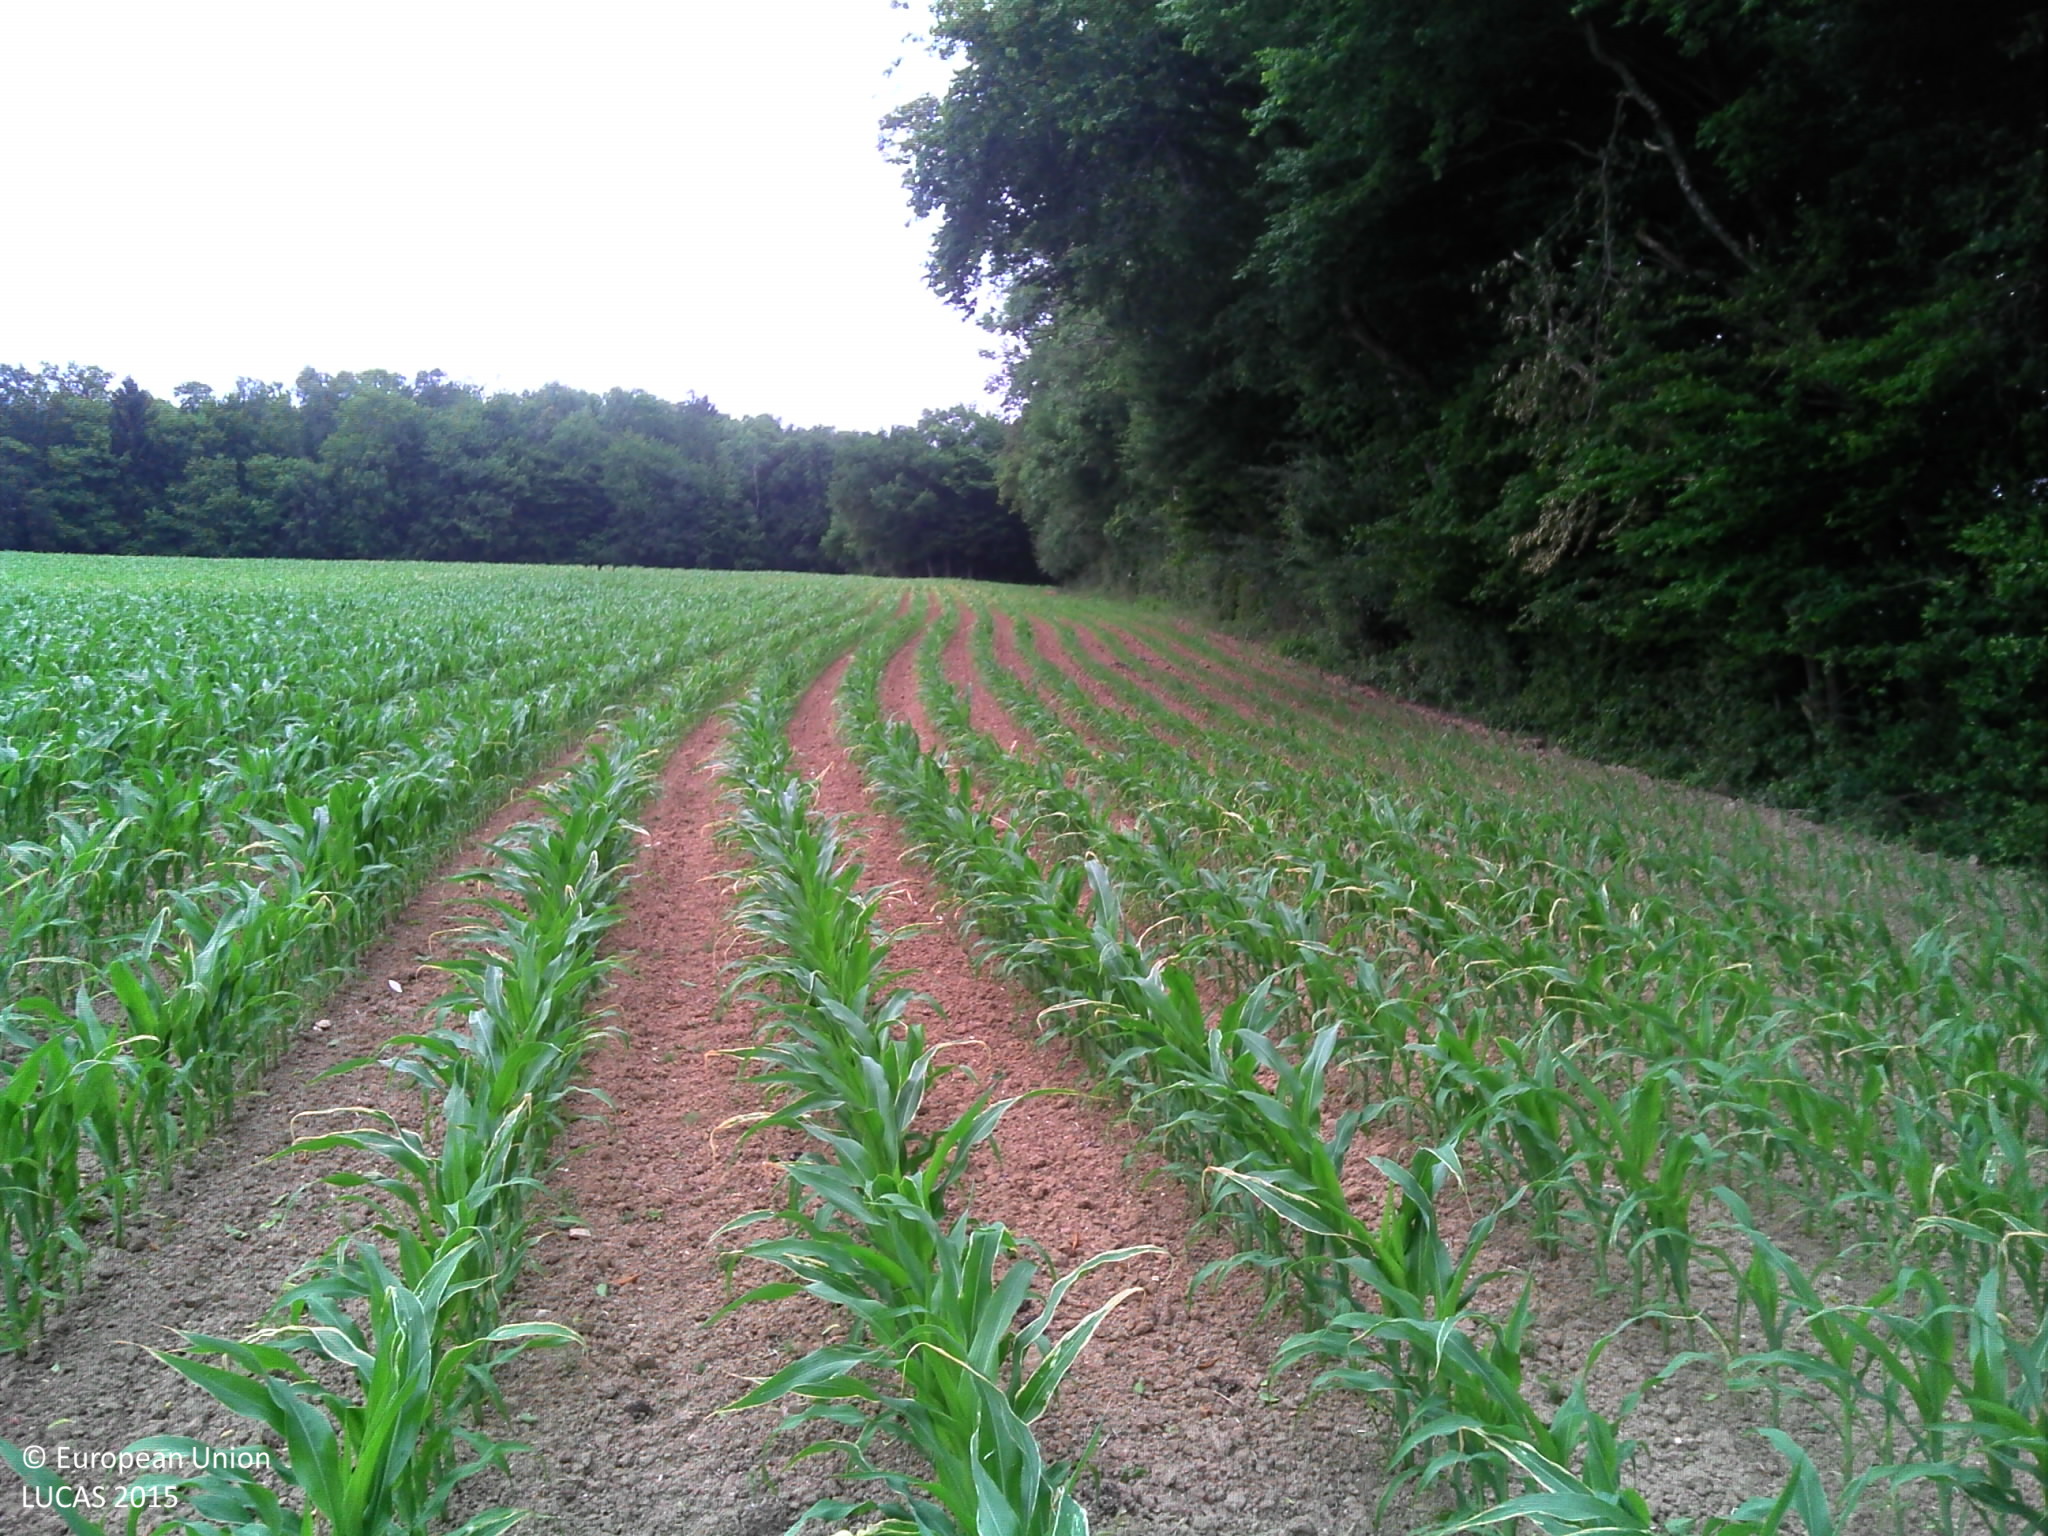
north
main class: Cropland
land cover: Maize
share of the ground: 50 - 75 %
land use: Agriculture (excluding fallow land and kitchen gardens)
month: June
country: FR
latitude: 47.4768
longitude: 6.2994
